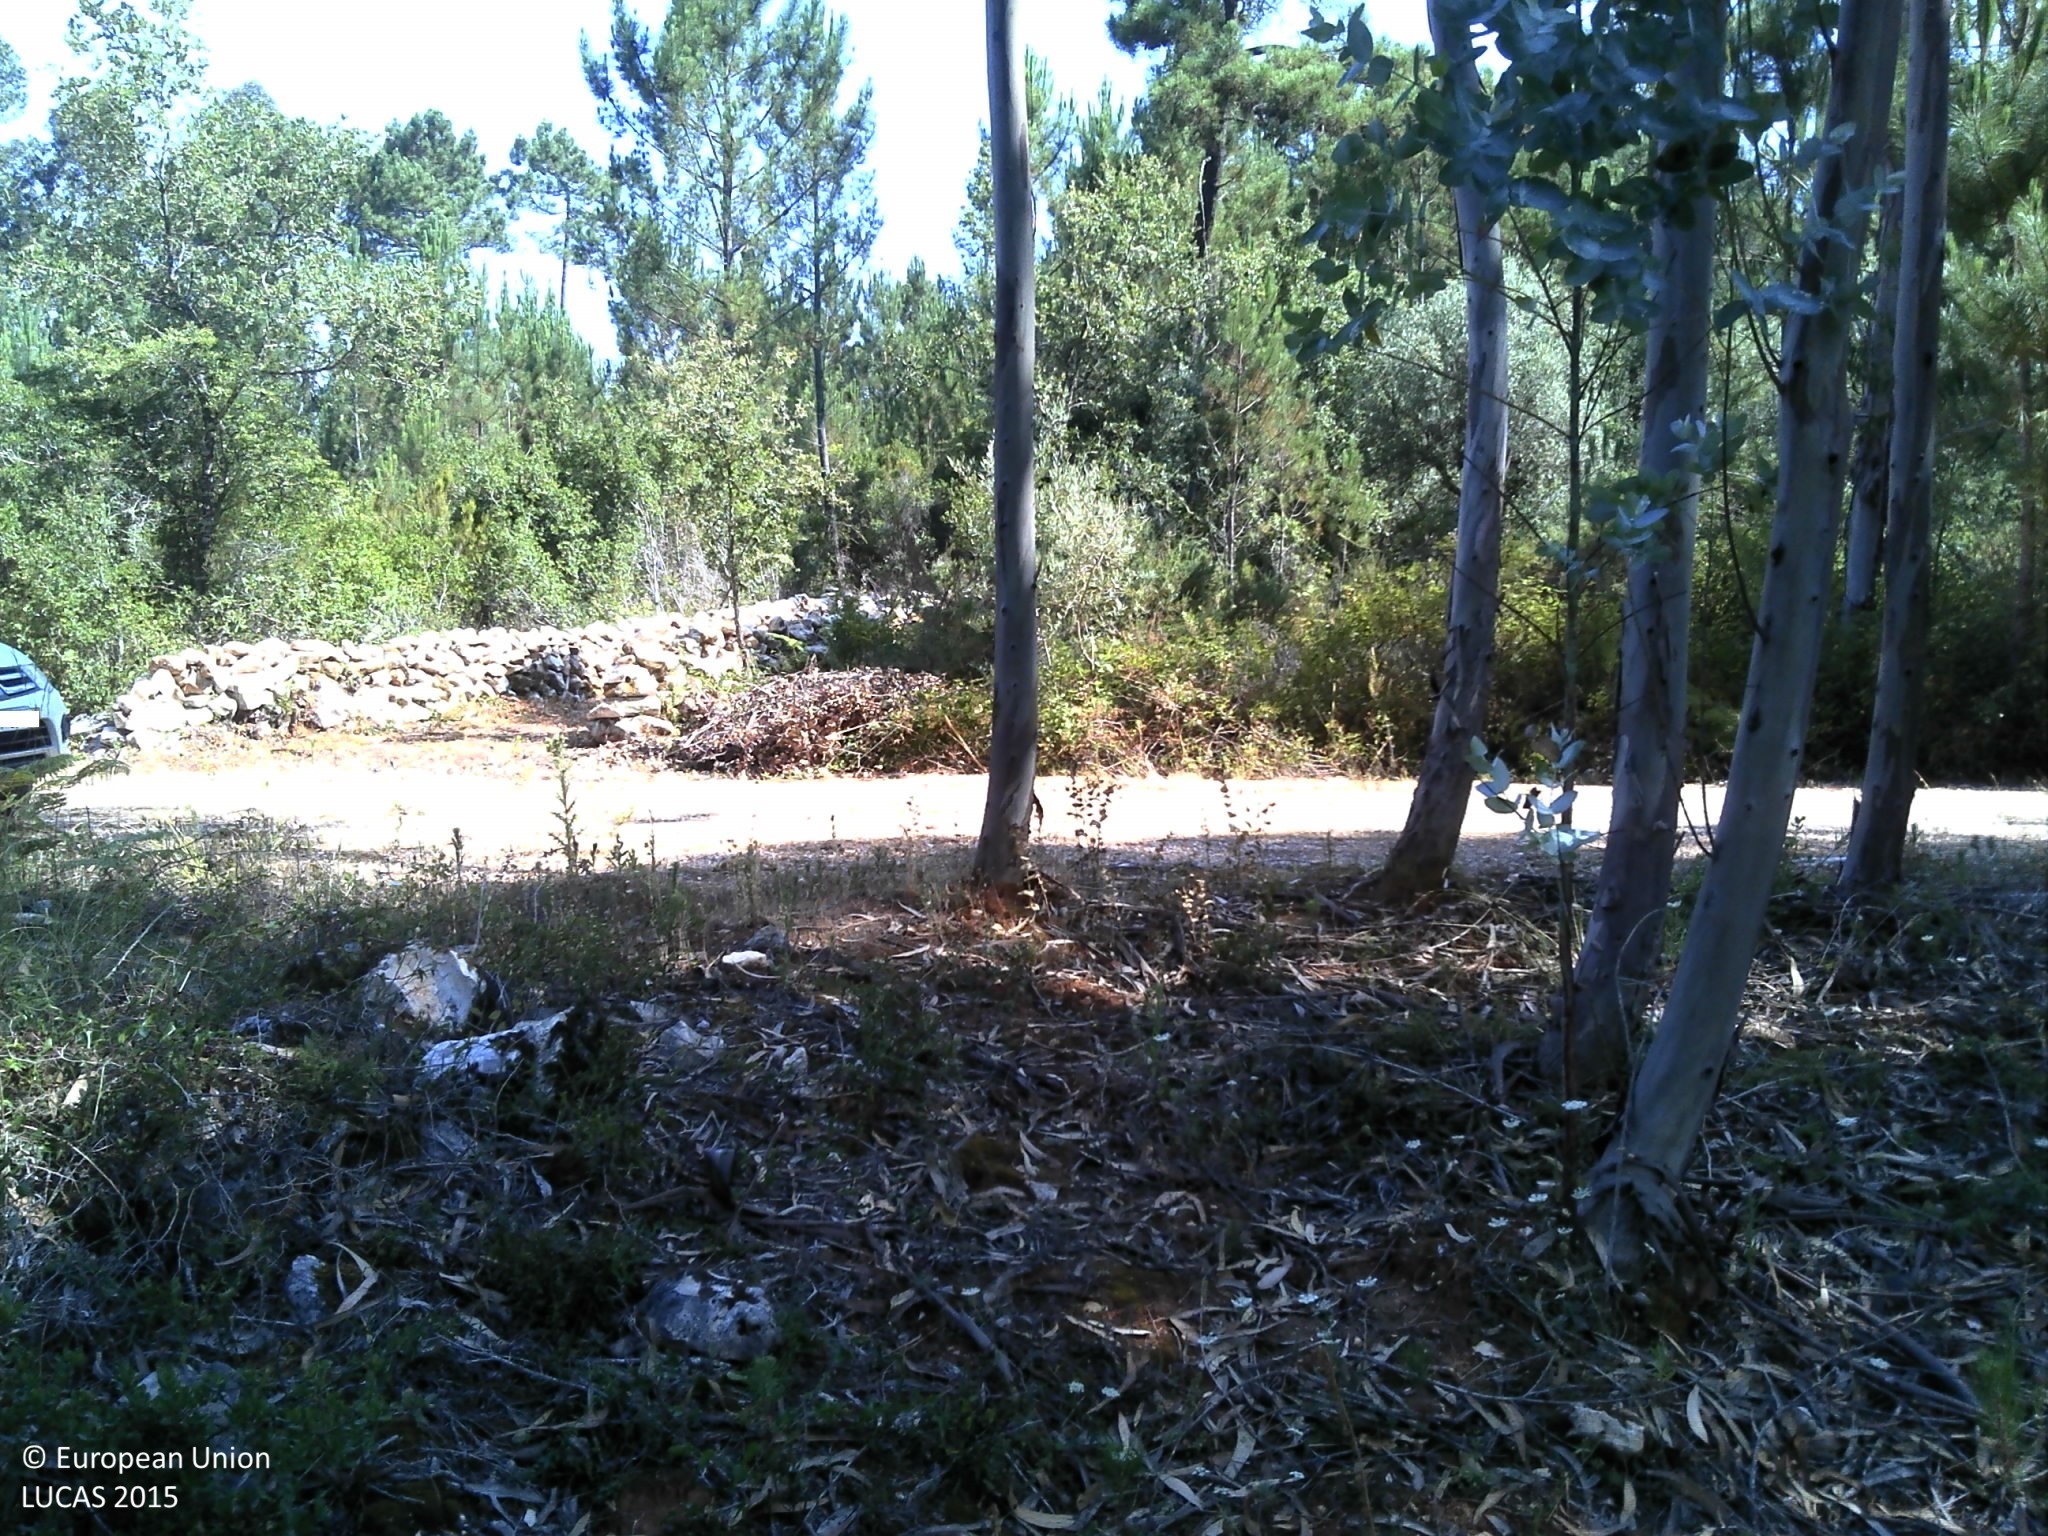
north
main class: Woodland
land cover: Broadleaved woodland
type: exotic forest
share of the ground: 50 - 75 %
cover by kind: broadleaved forest trees 55 %, unconsolidated bare surface 40 %, shrubs 5 %
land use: Forestry
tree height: > 5 m
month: July
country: PT
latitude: 39.9403
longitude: -8.4653
